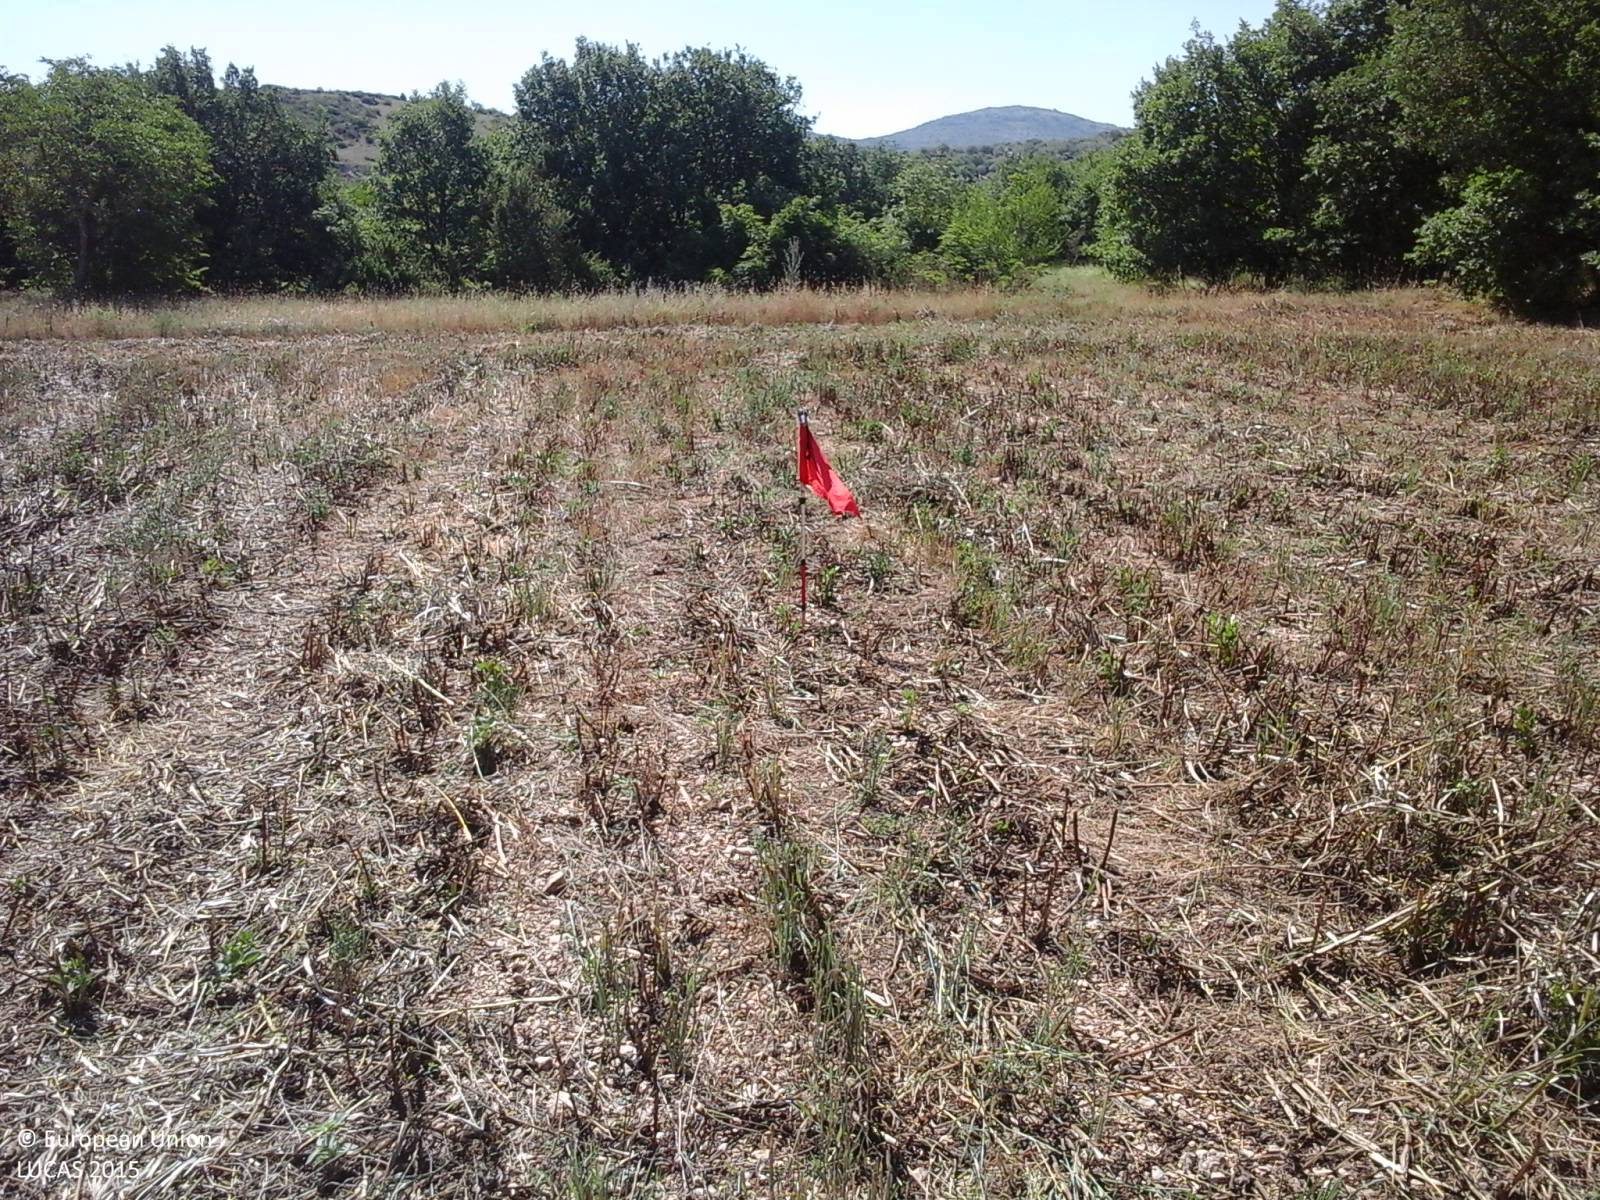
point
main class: Cropland
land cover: Lucerne
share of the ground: > 75 %
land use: Agriculture (excluding fallow land and kitchen gardens)
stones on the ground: 10 - 25 %
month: June
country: IT
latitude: 42.2778
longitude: 13.7349
